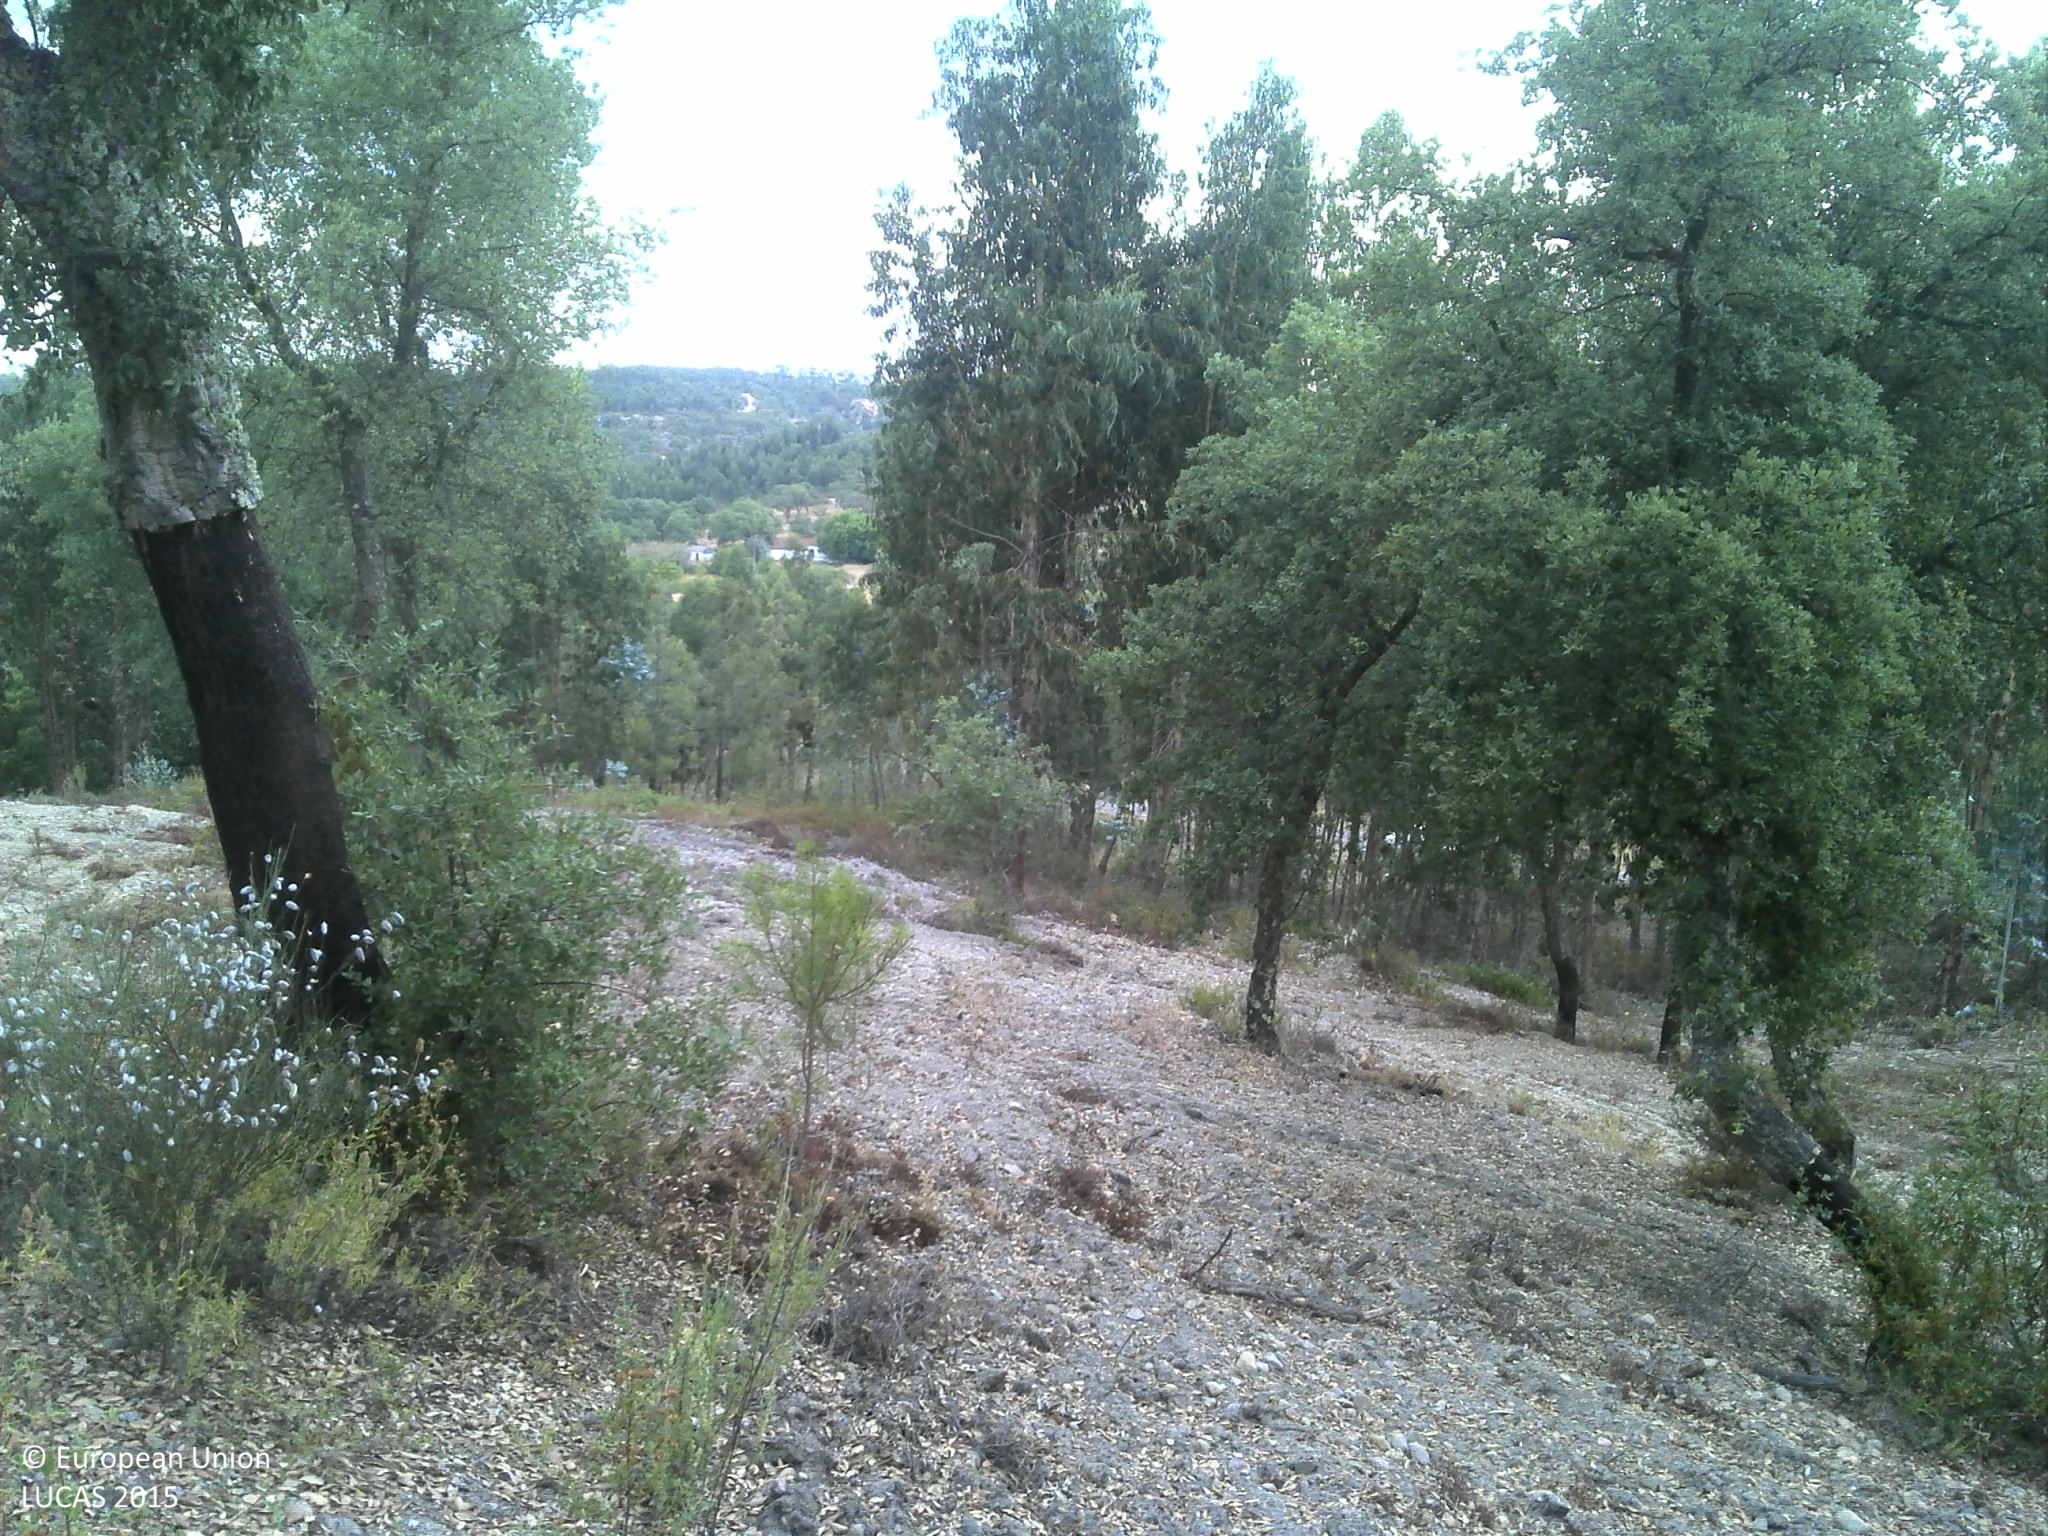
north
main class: Woodland
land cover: Broadleaved woodland
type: broadleaved evergreen forest
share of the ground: 25 - 50 %
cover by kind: broadleaved forest trees 50 %, unconsolidated bare surface 40 %, herbaceous plants 10 %
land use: Forestry
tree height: > 5 m
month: June
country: PT
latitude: 39.3351
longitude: -8.0516
